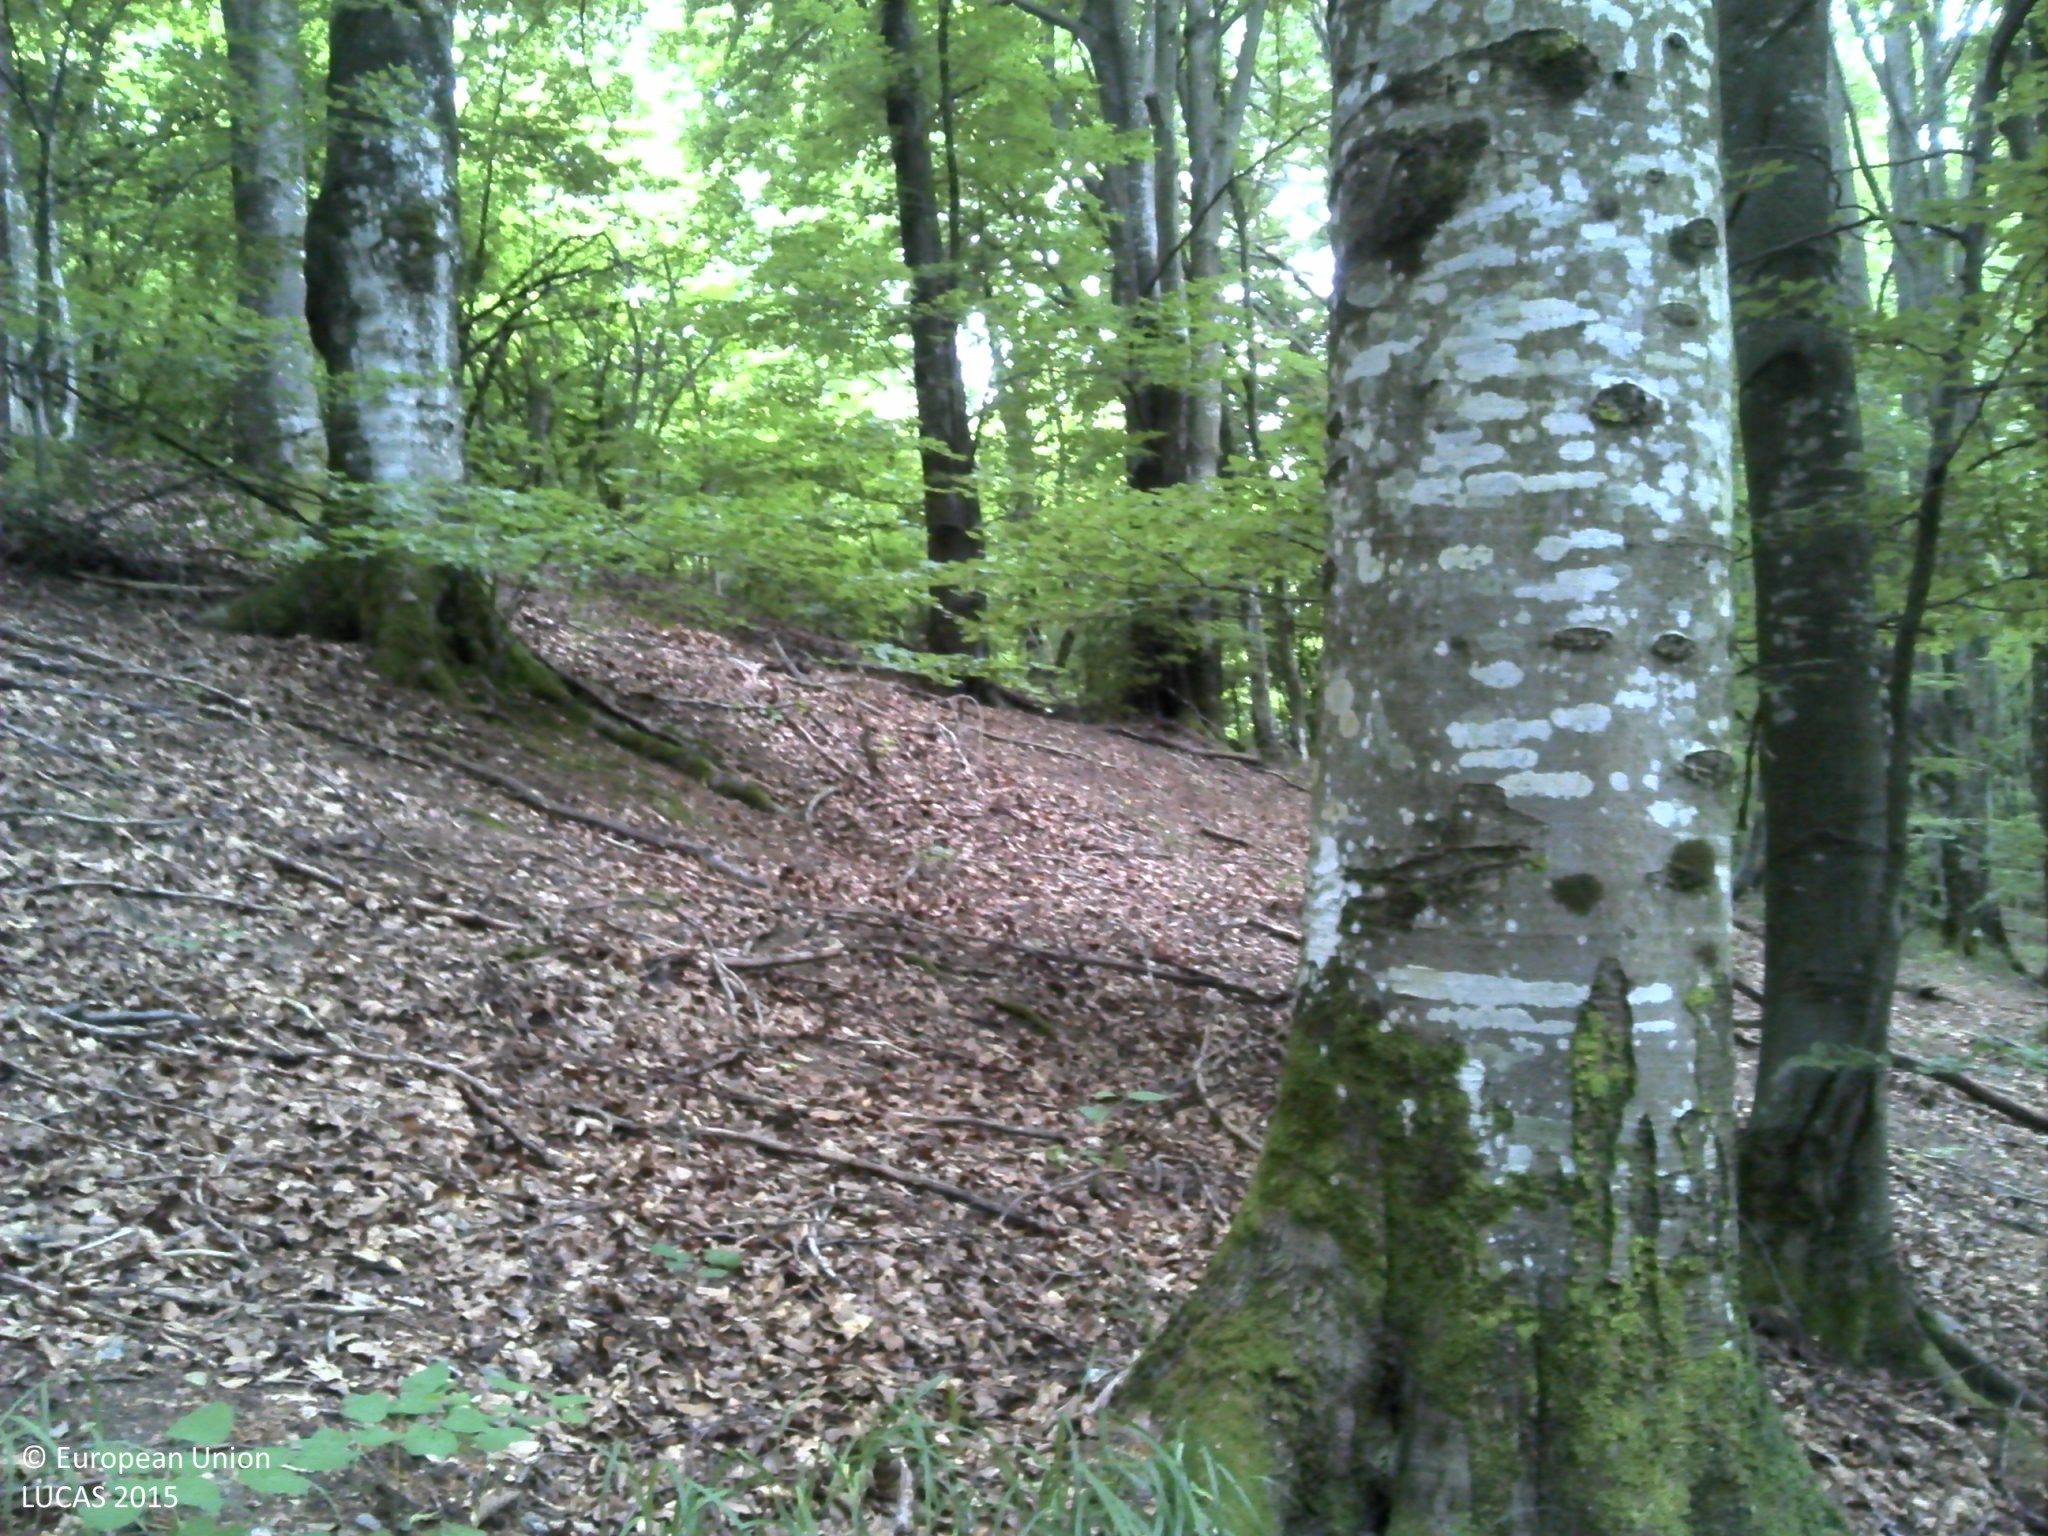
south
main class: Woodland
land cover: Broadleaved woodland
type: beech forest
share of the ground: > 75 %
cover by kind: broadleaved forest trees 100 %
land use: Forestry
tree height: > 5 m
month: June
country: HR
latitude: 45.4774
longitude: 17.4336
